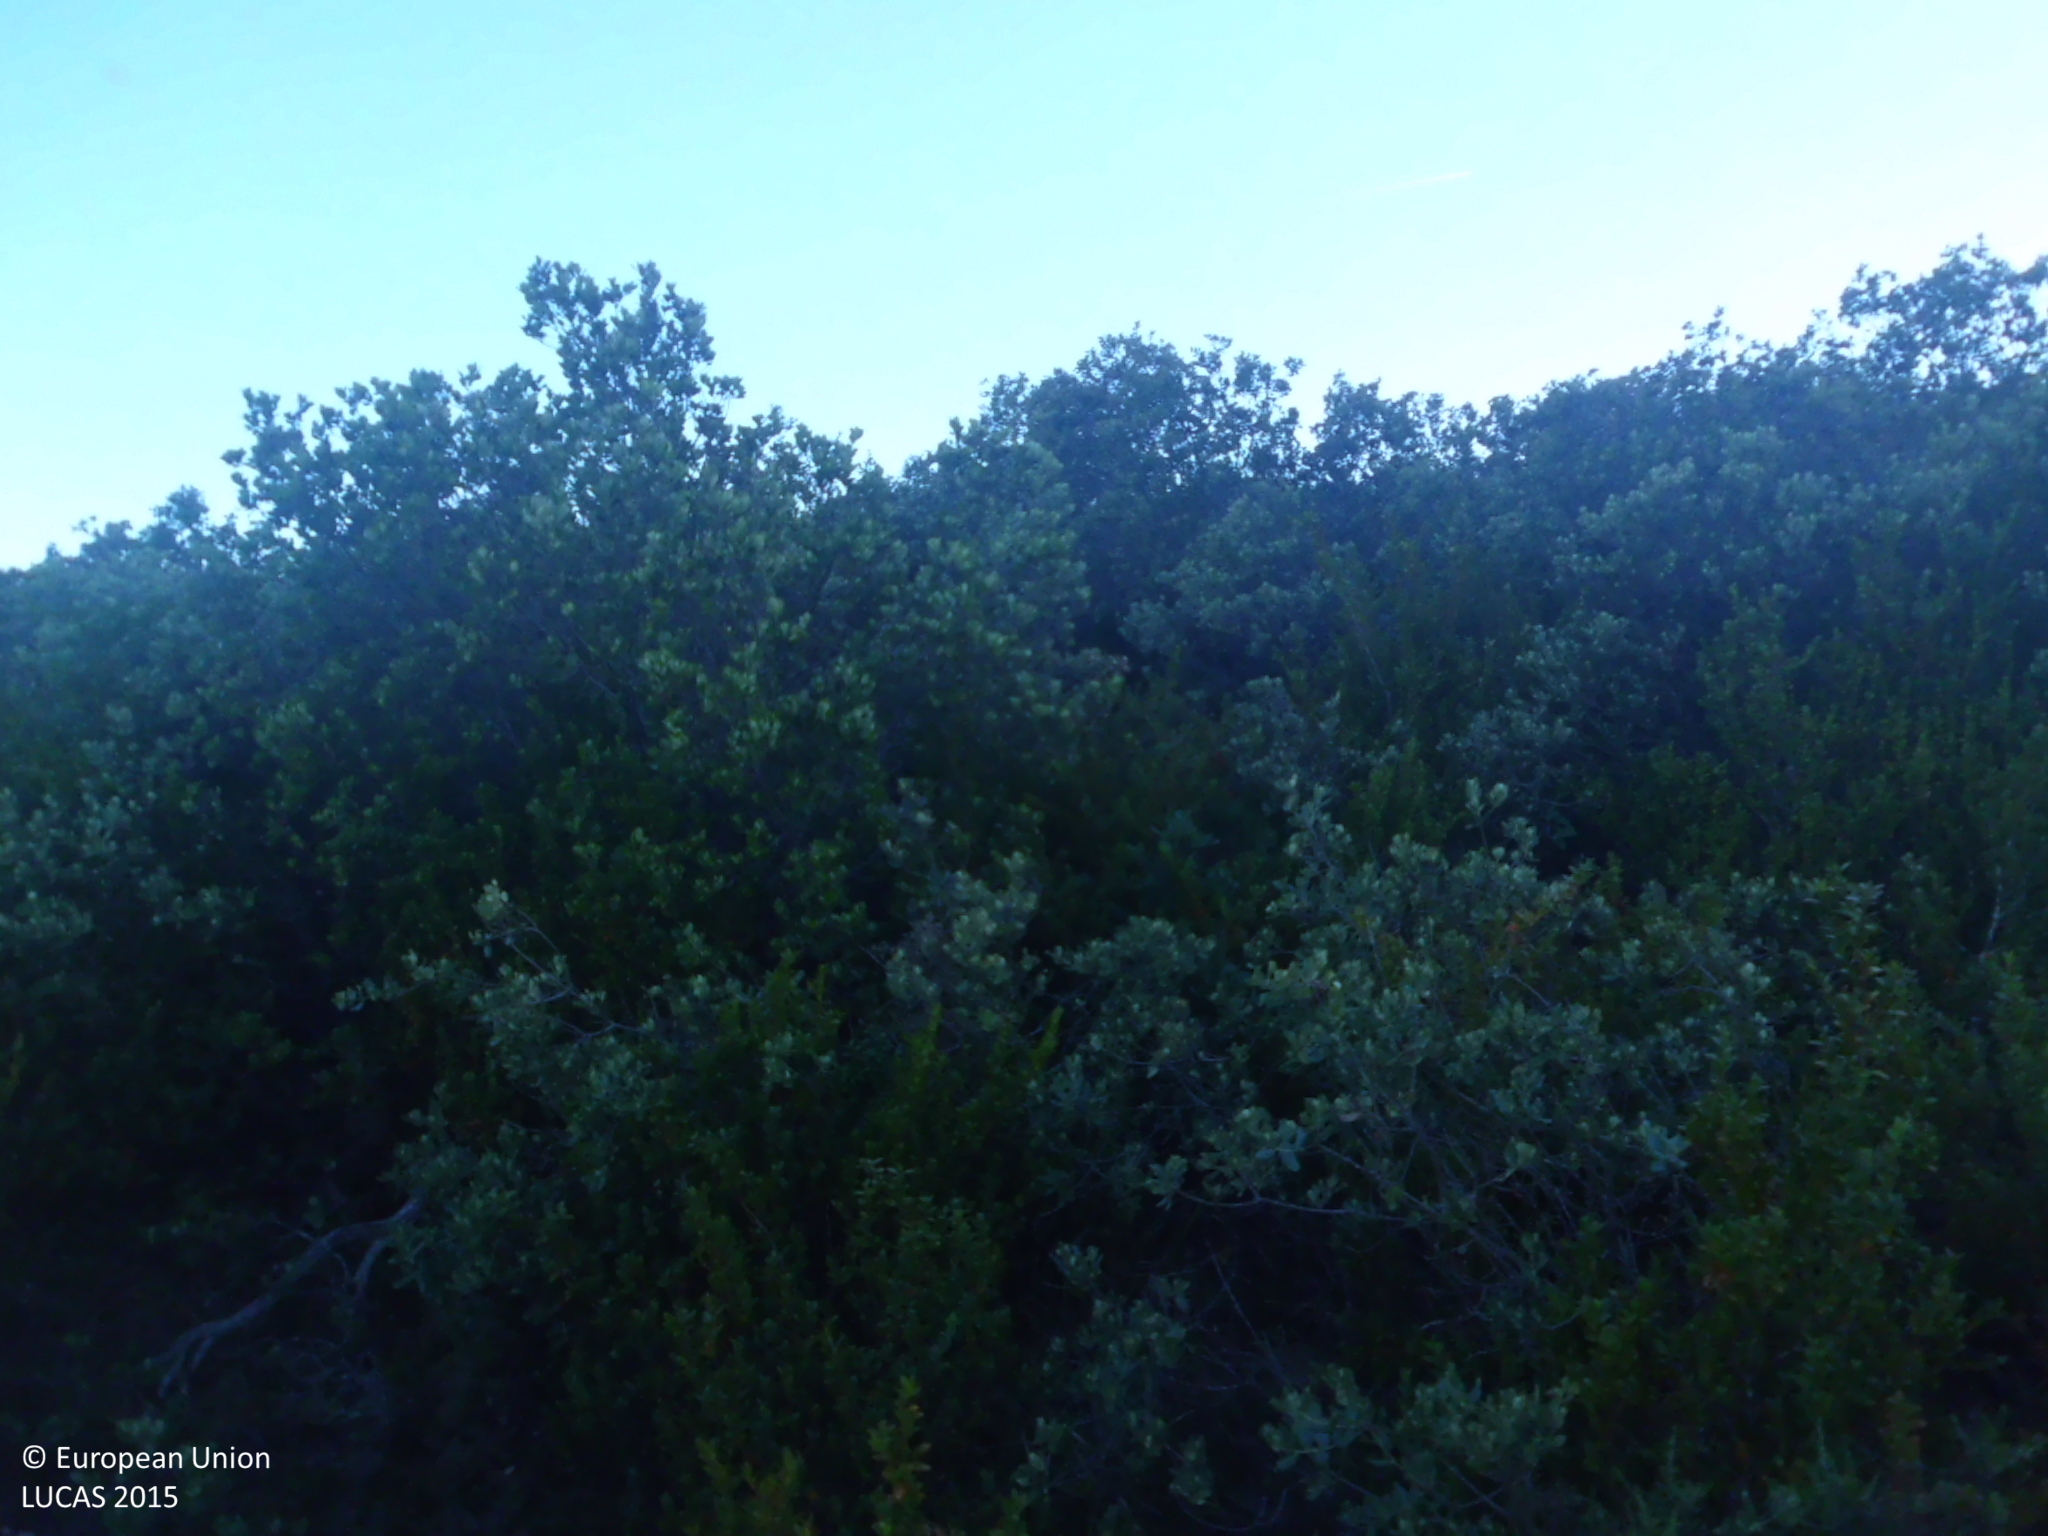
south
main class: Woodland
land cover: Broadleaved woodland
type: thermophilous deciduous forest
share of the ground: 25 - 50 %
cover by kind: broadleaved forest trees 45 %, shrubs 45 %, herbaceous plants 10 %
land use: Semi-natural and natural areas not in use
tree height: < 5 m
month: June
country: ES
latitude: 42.7831
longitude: -3.3969
